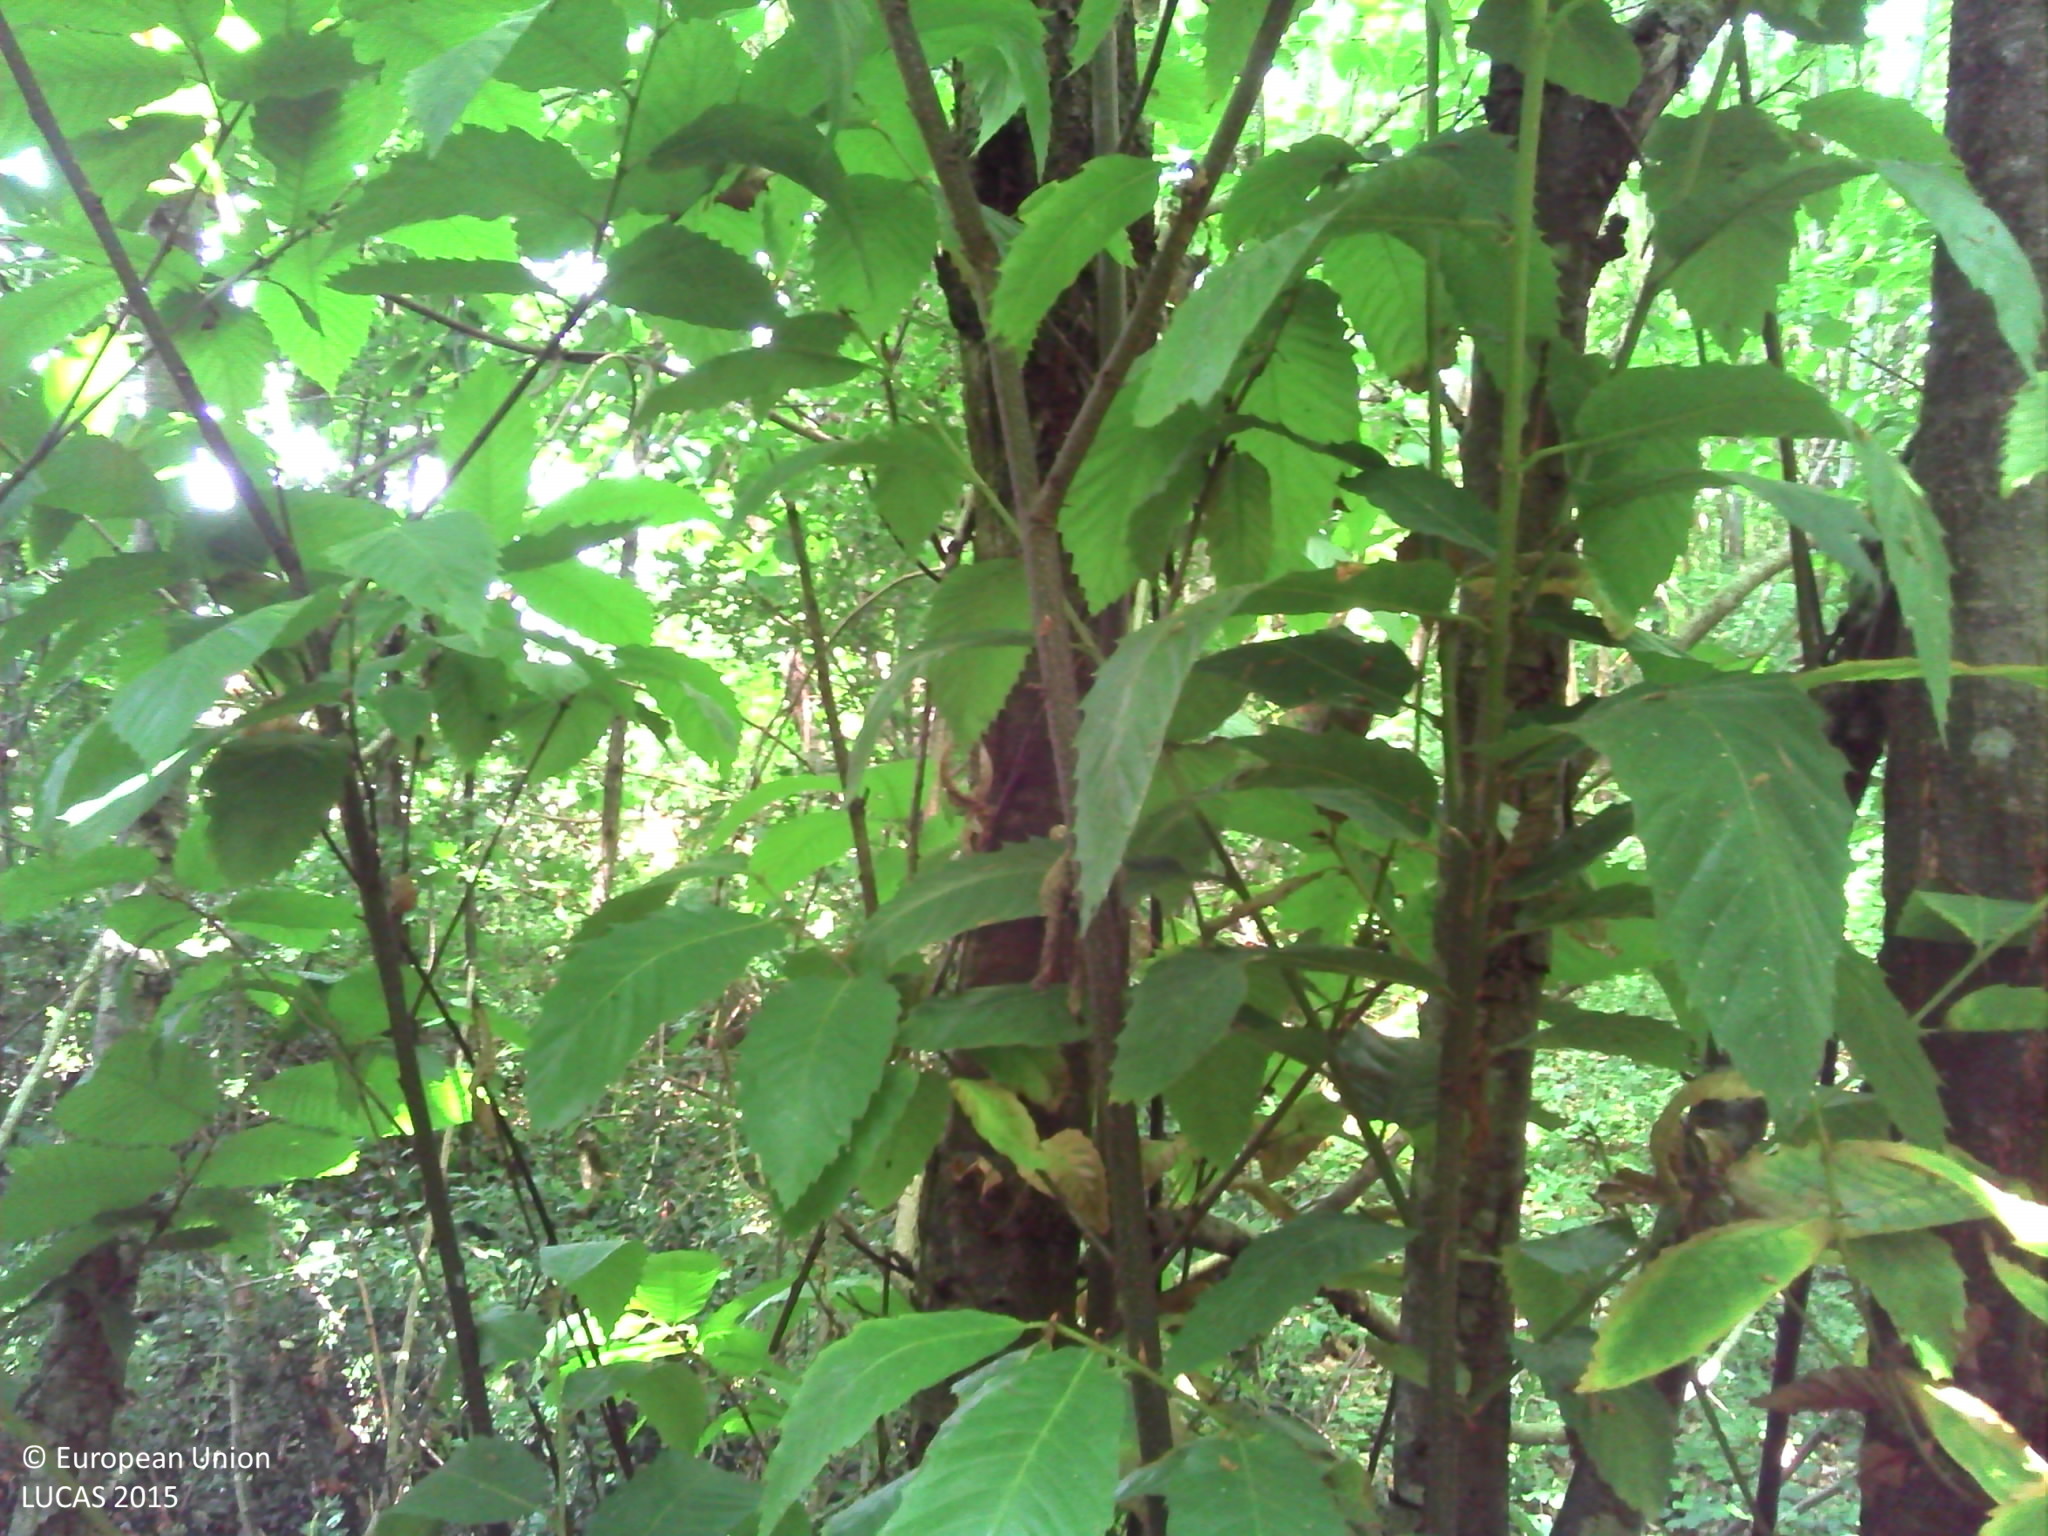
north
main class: Woodland
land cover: Broadleaved woodland
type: thermophilous deciduous forest
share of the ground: > 75 %
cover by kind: broadleaved forest trees 100 %
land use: Forestry
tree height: > 5 m
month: June
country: FR
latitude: 45.8762
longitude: 0.3340
